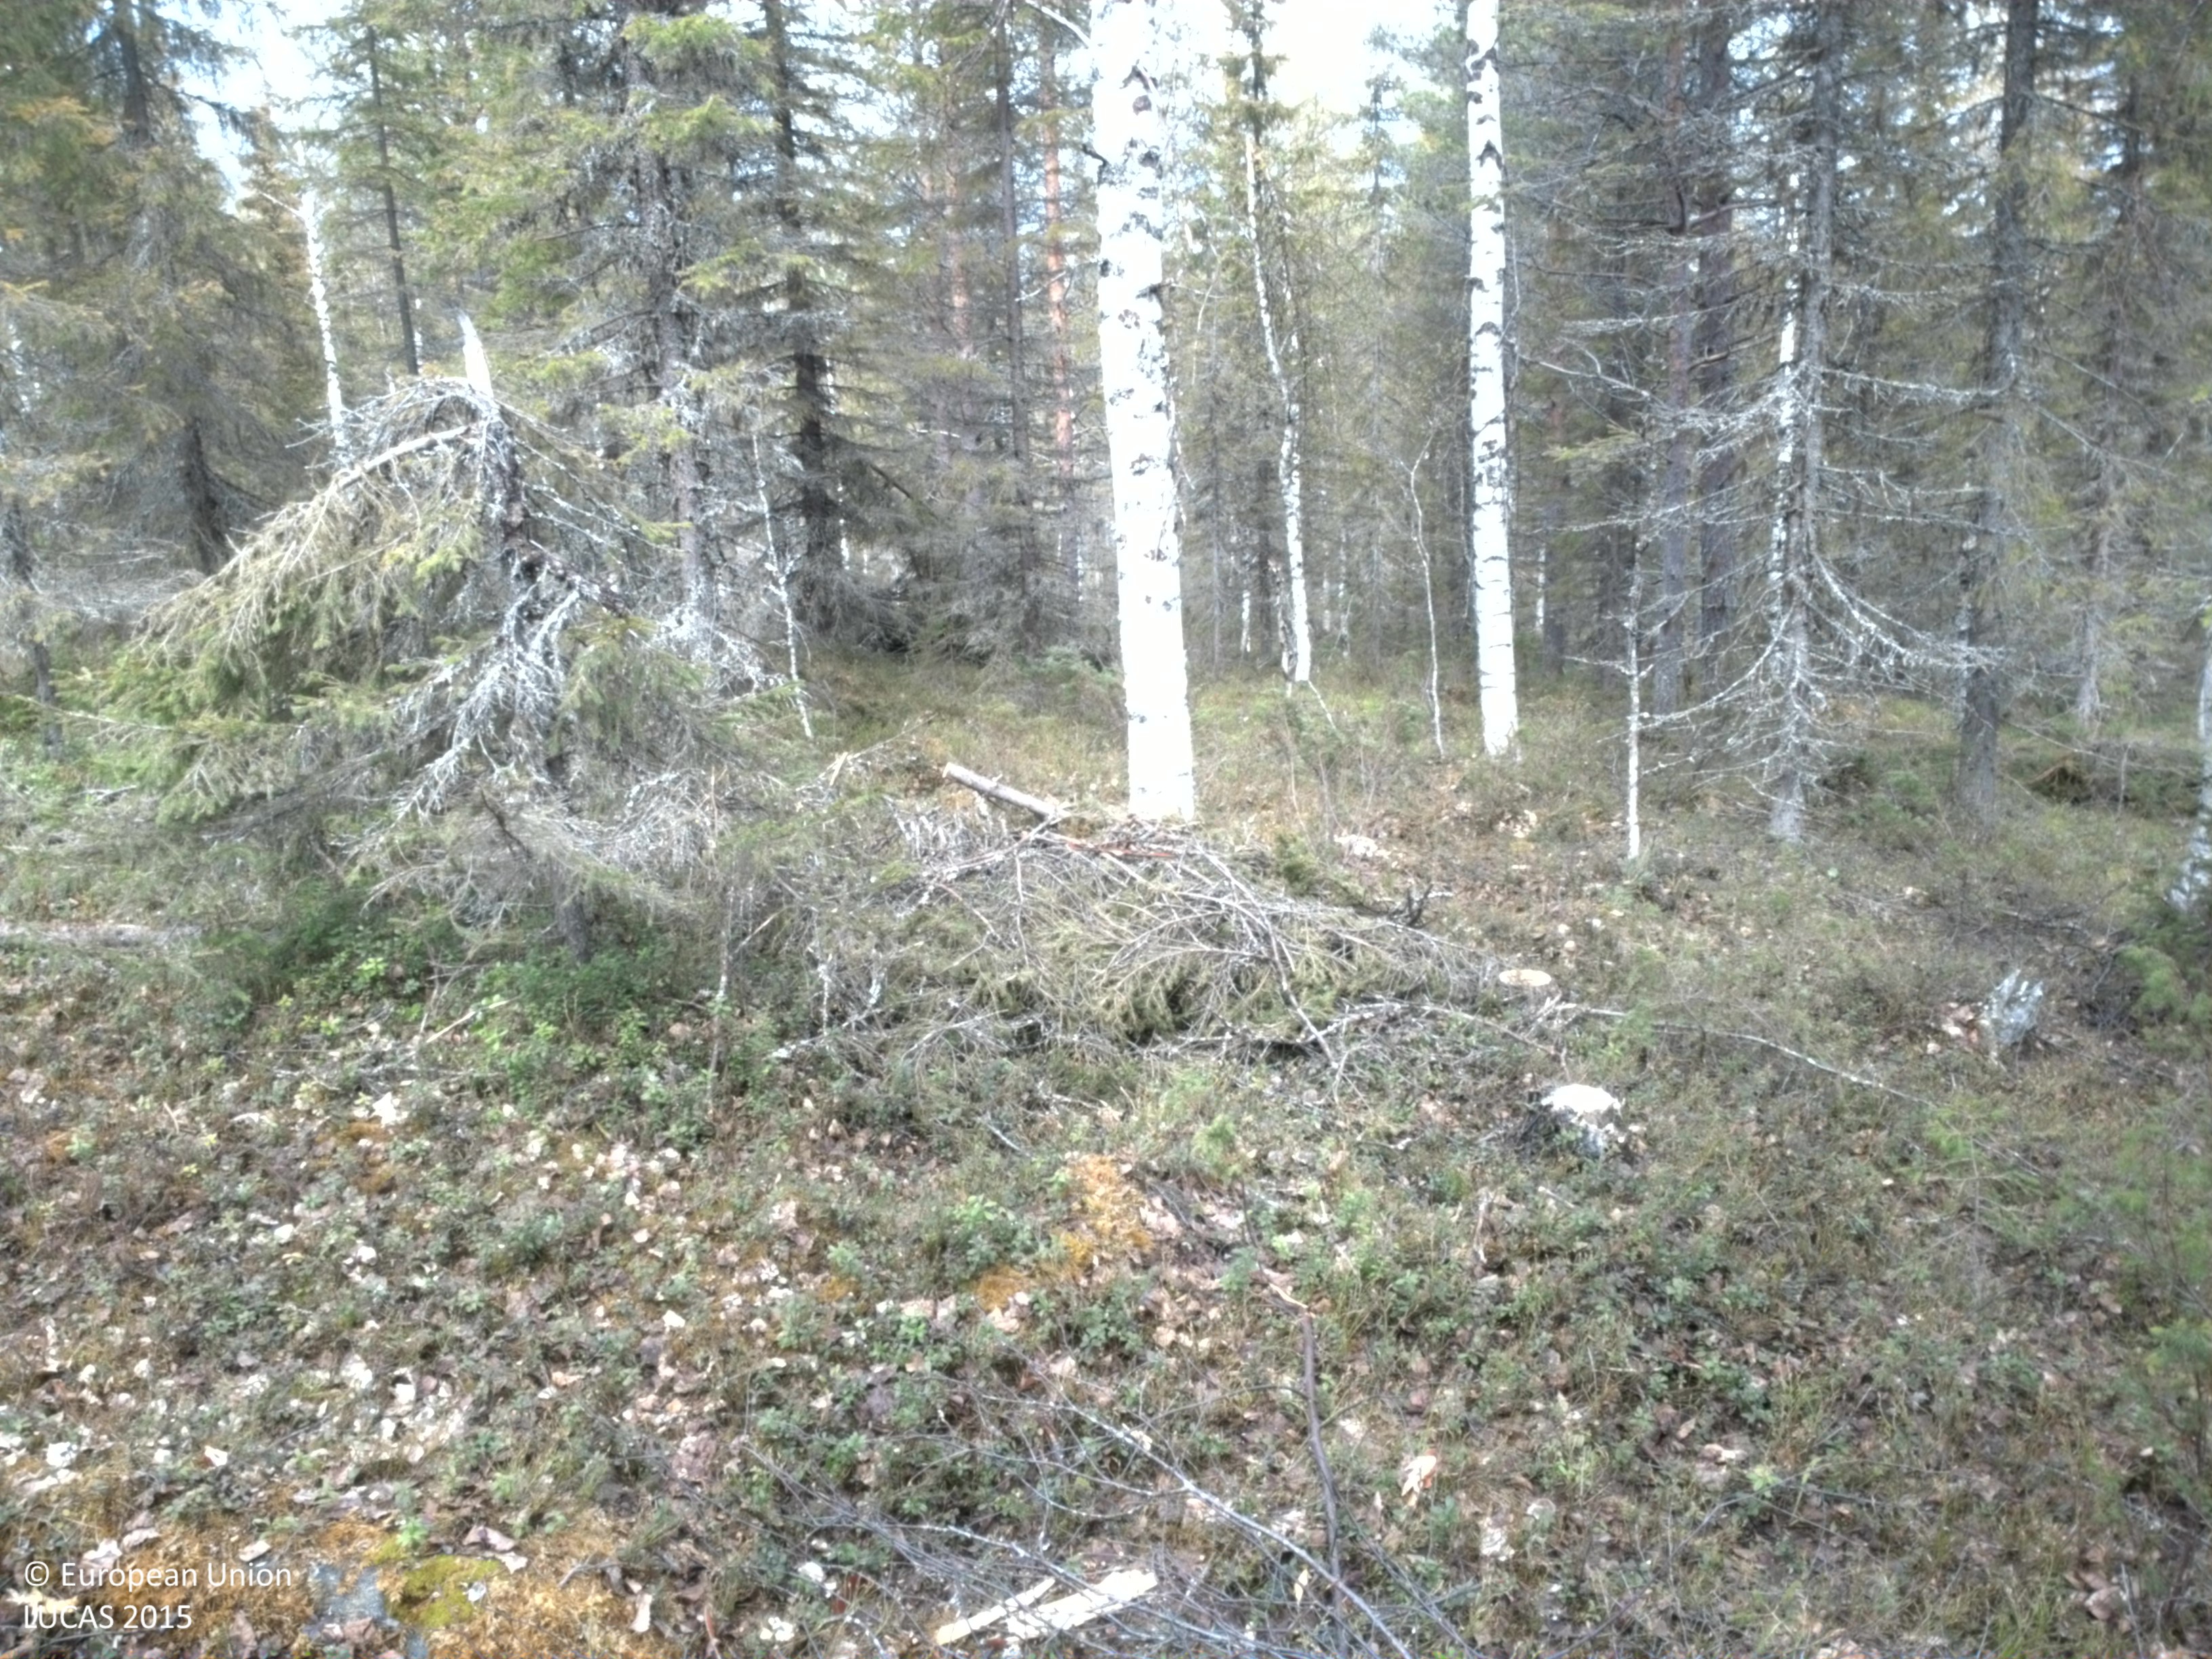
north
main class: Woodland
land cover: Spruce dominated mixed woodland
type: boreal forest
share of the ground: 50 - 75 %
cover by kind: coniferous forest trees 55 %, shrubs 25 %, broadleaved forest trees 20 %
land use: Forestry
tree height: > 5 m
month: June
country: SE
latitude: 66.4982
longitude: 23.3531
